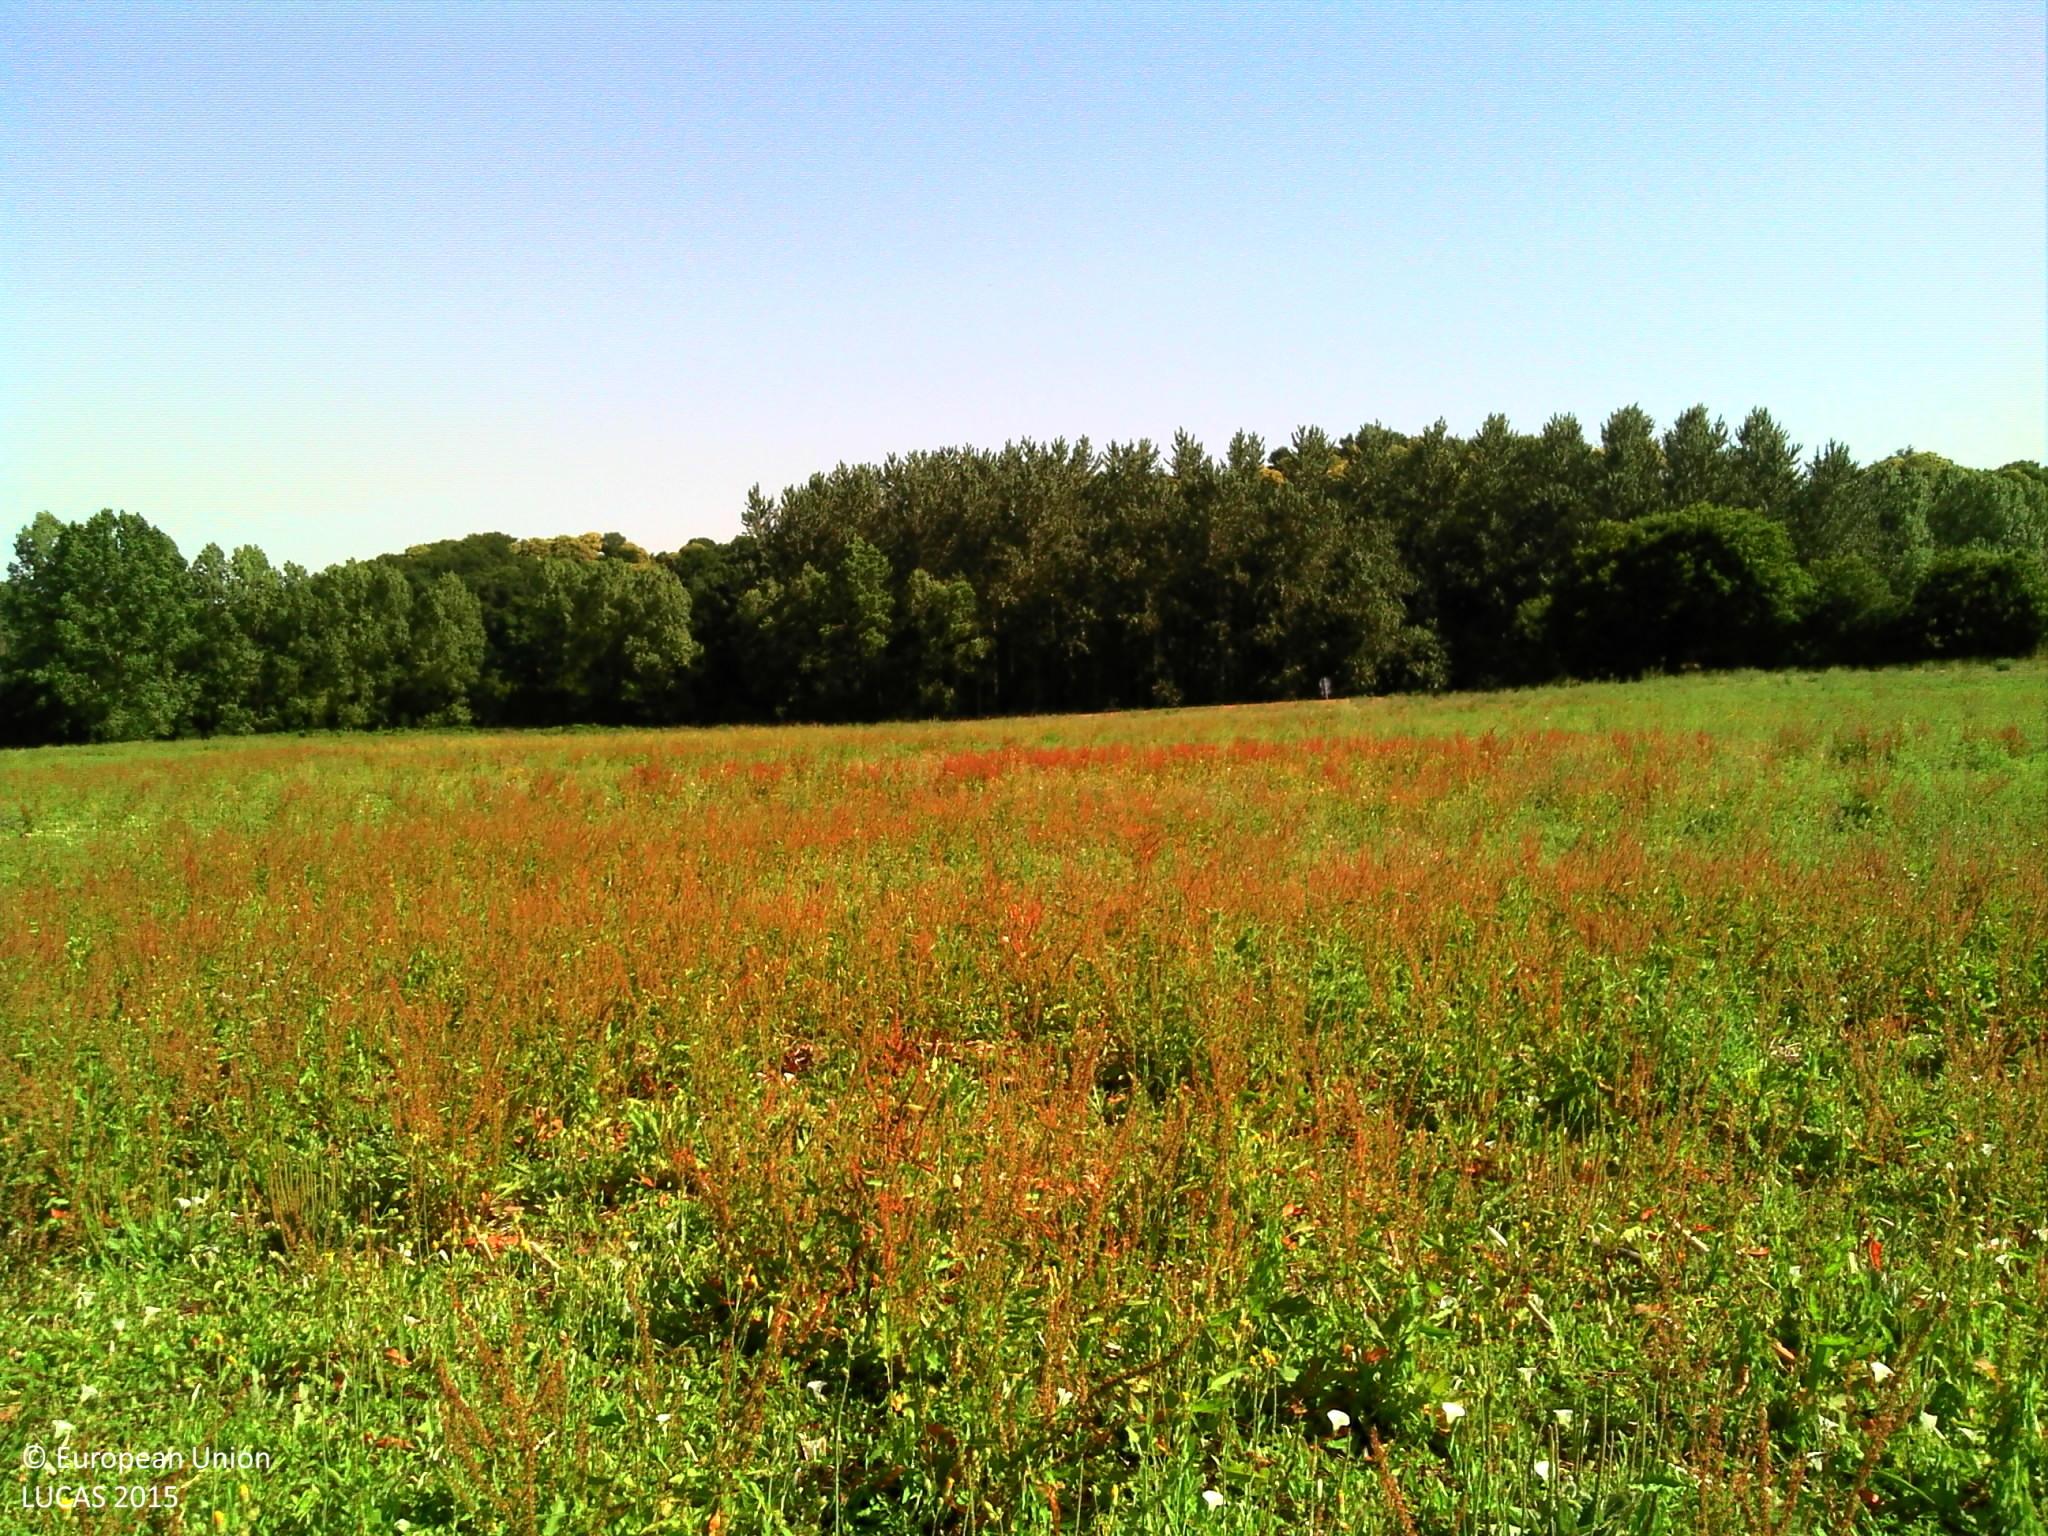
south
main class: Grassland
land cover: Spontaneously vegetated surfaces
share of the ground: > 75 %
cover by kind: herbaceous plants 90 %, unconsolidated bare surface 10 %
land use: Fallow land
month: July
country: FR
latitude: 48.3683
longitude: -2.4660
